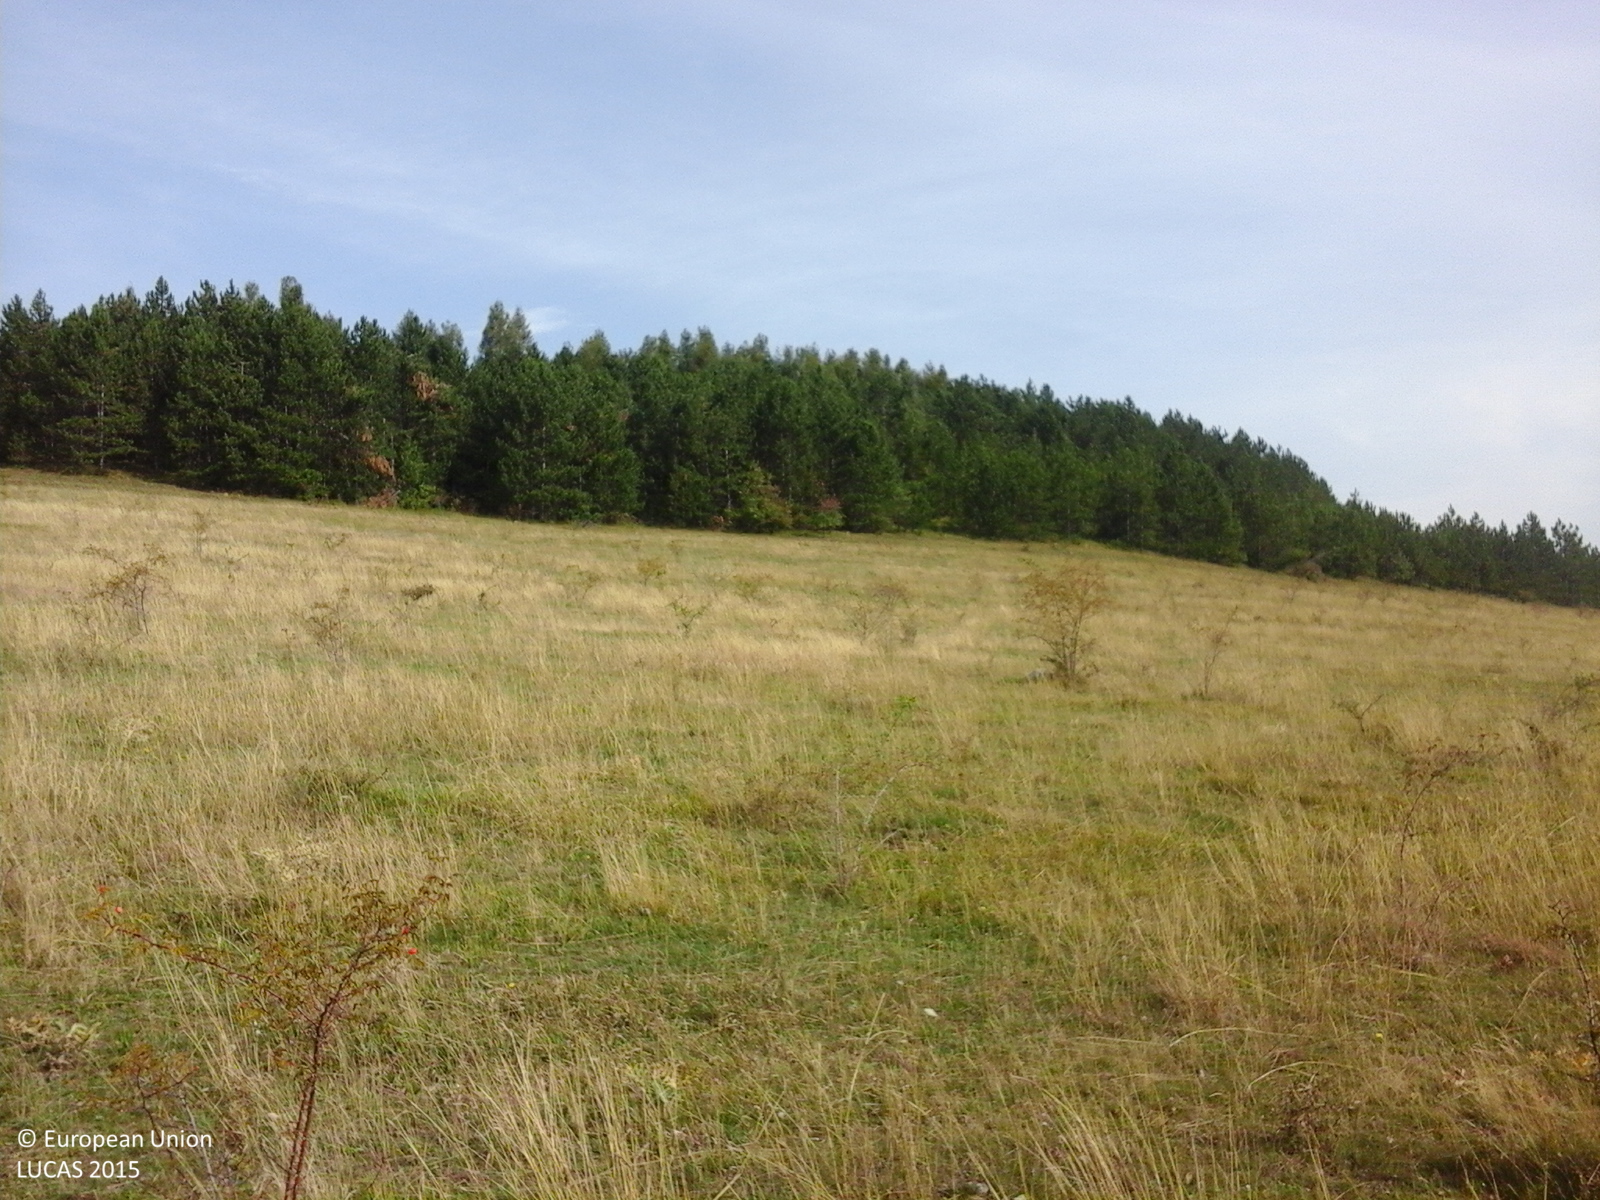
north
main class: Grassland
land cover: Spontaneously vegetated surfaces
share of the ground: > 75 %
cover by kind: herbaceous plants 100 %
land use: Fallow land
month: September
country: RO
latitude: 46.8528
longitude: 23.1129
